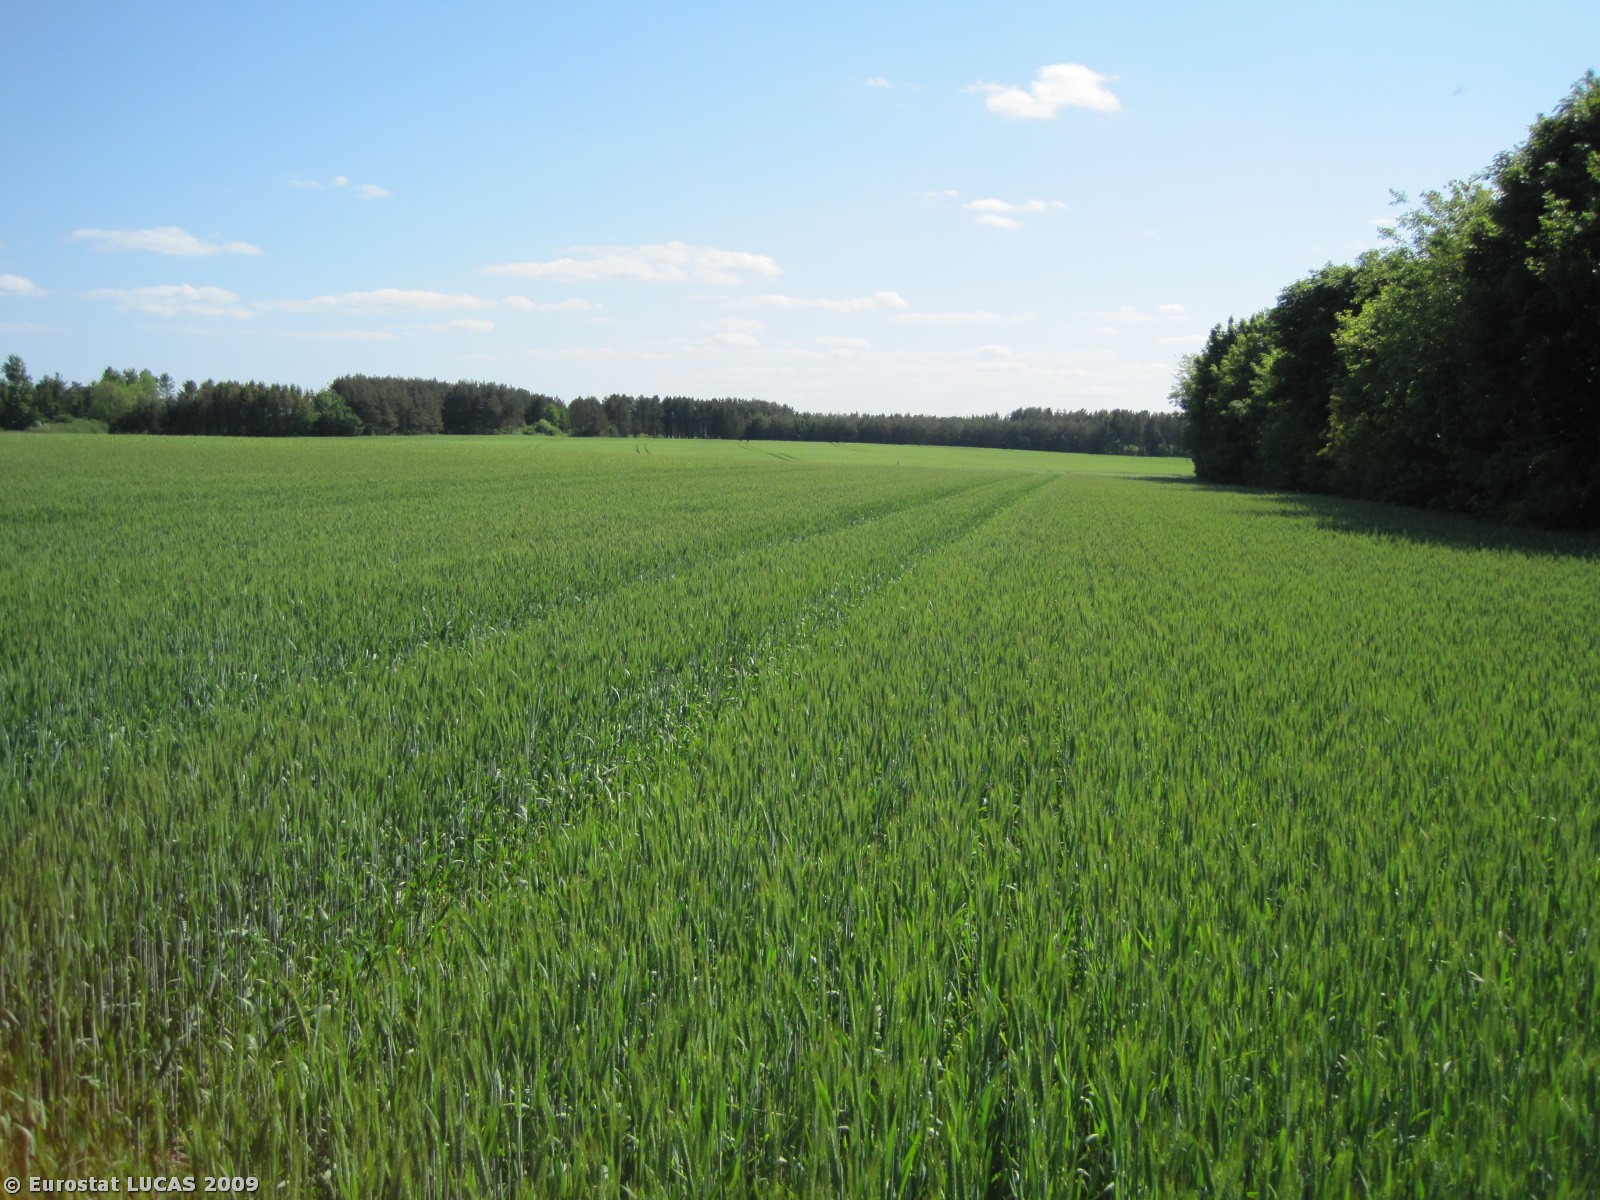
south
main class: Cropland
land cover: Barley
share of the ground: > 75 %
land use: Agriculture (excluding fallow land and kitchen gardens)
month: May
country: DK
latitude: 56.4572
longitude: 10.2107
